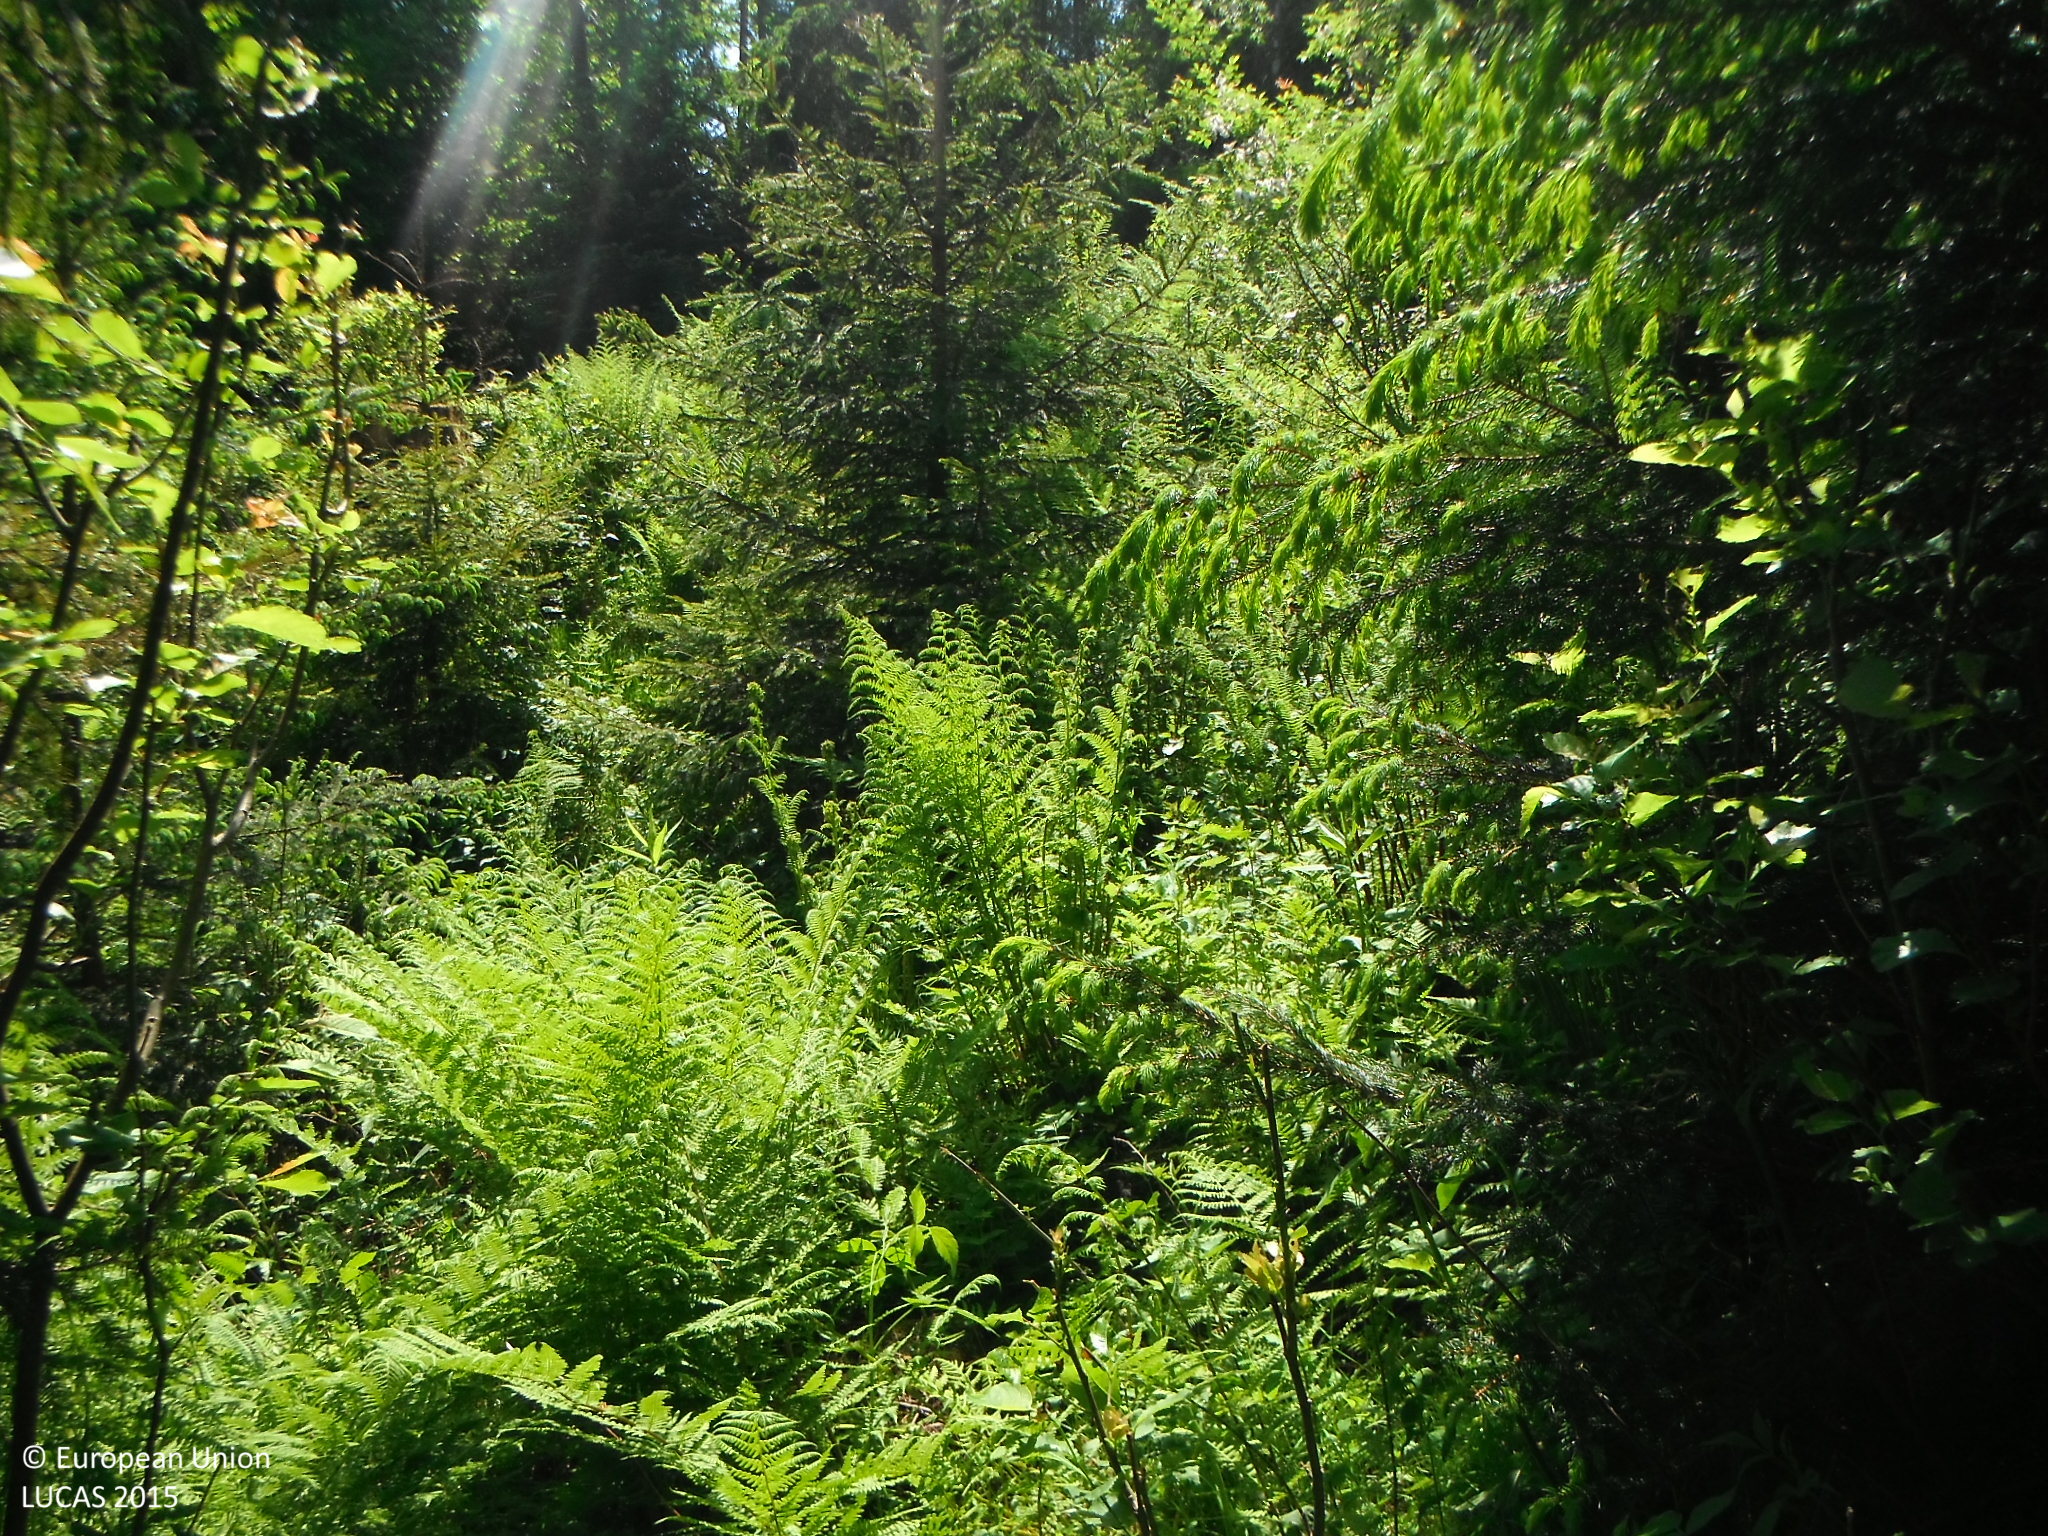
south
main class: Woodland
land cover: Other mixed woodland
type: hemiboreal forest and nemoral coniferous forest and mixed broadleaved-coniferous forest
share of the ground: > 75 %
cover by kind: coniferous forest trees 60 %, broadleaved forest trees 40 %
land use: Forestry
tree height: > 5 m
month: June
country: SK
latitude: 49.3216
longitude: 20.2561
